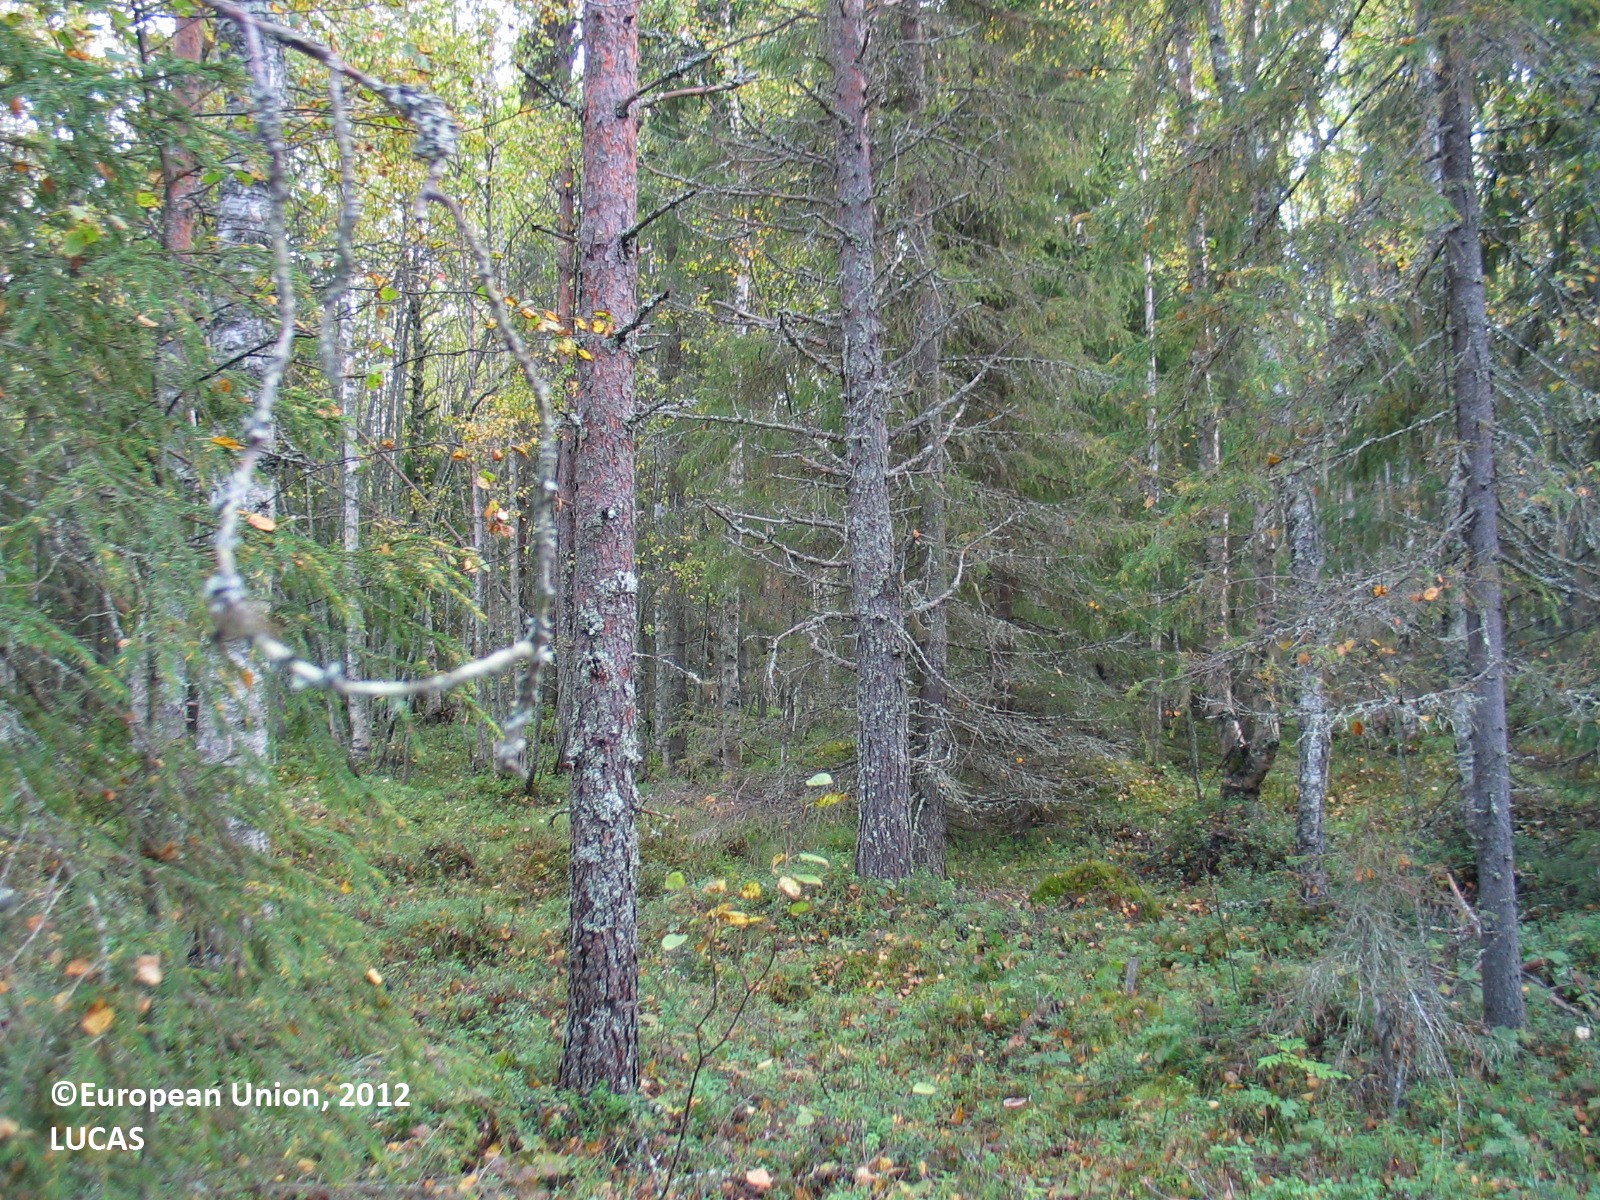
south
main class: Woodland
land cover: Other mixed woodland
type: mire and swamp forests
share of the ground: 25 - 50 %
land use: Forestry
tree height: > 5 m
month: September
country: FI
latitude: 65.6156
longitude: 25.8209
